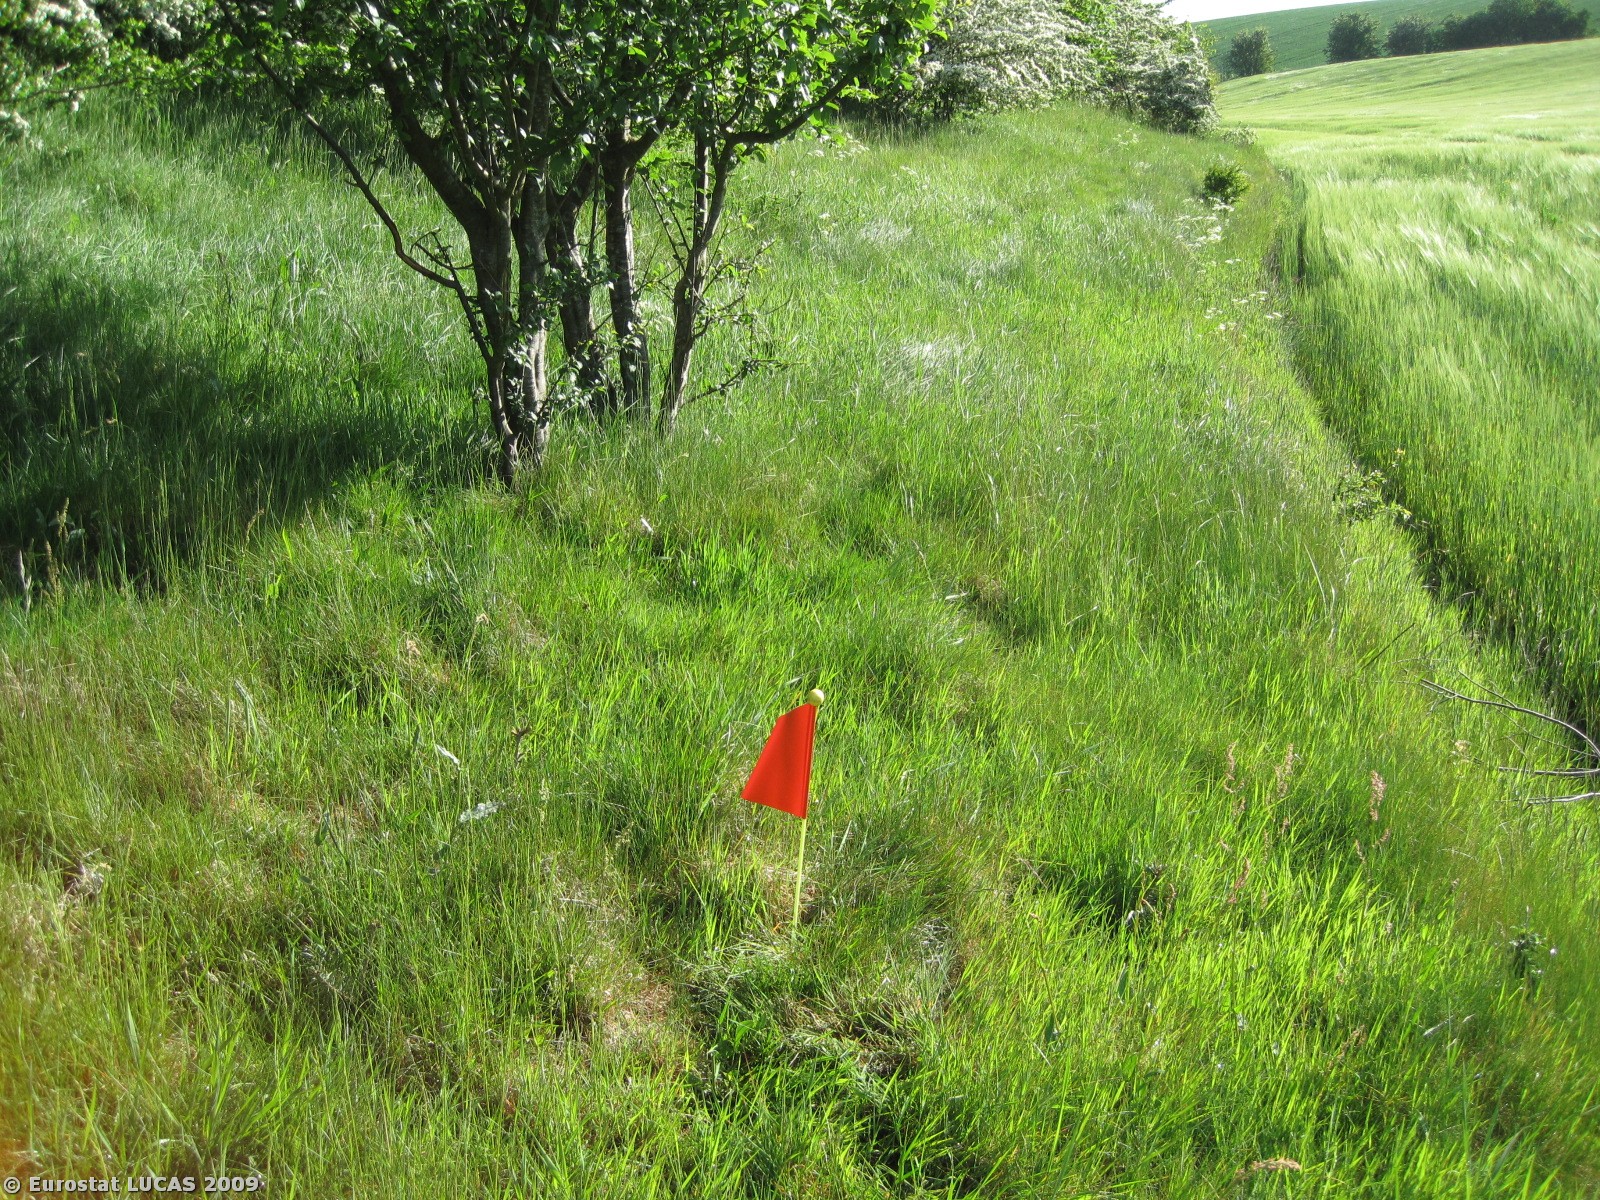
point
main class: Woodland
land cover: Broadleaved woodland
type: mesophytic deciduous forest
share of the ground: > 75 %
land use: Unused
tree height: > 5 m
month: May
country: DK
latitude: 56.5652
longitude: 10.1138
